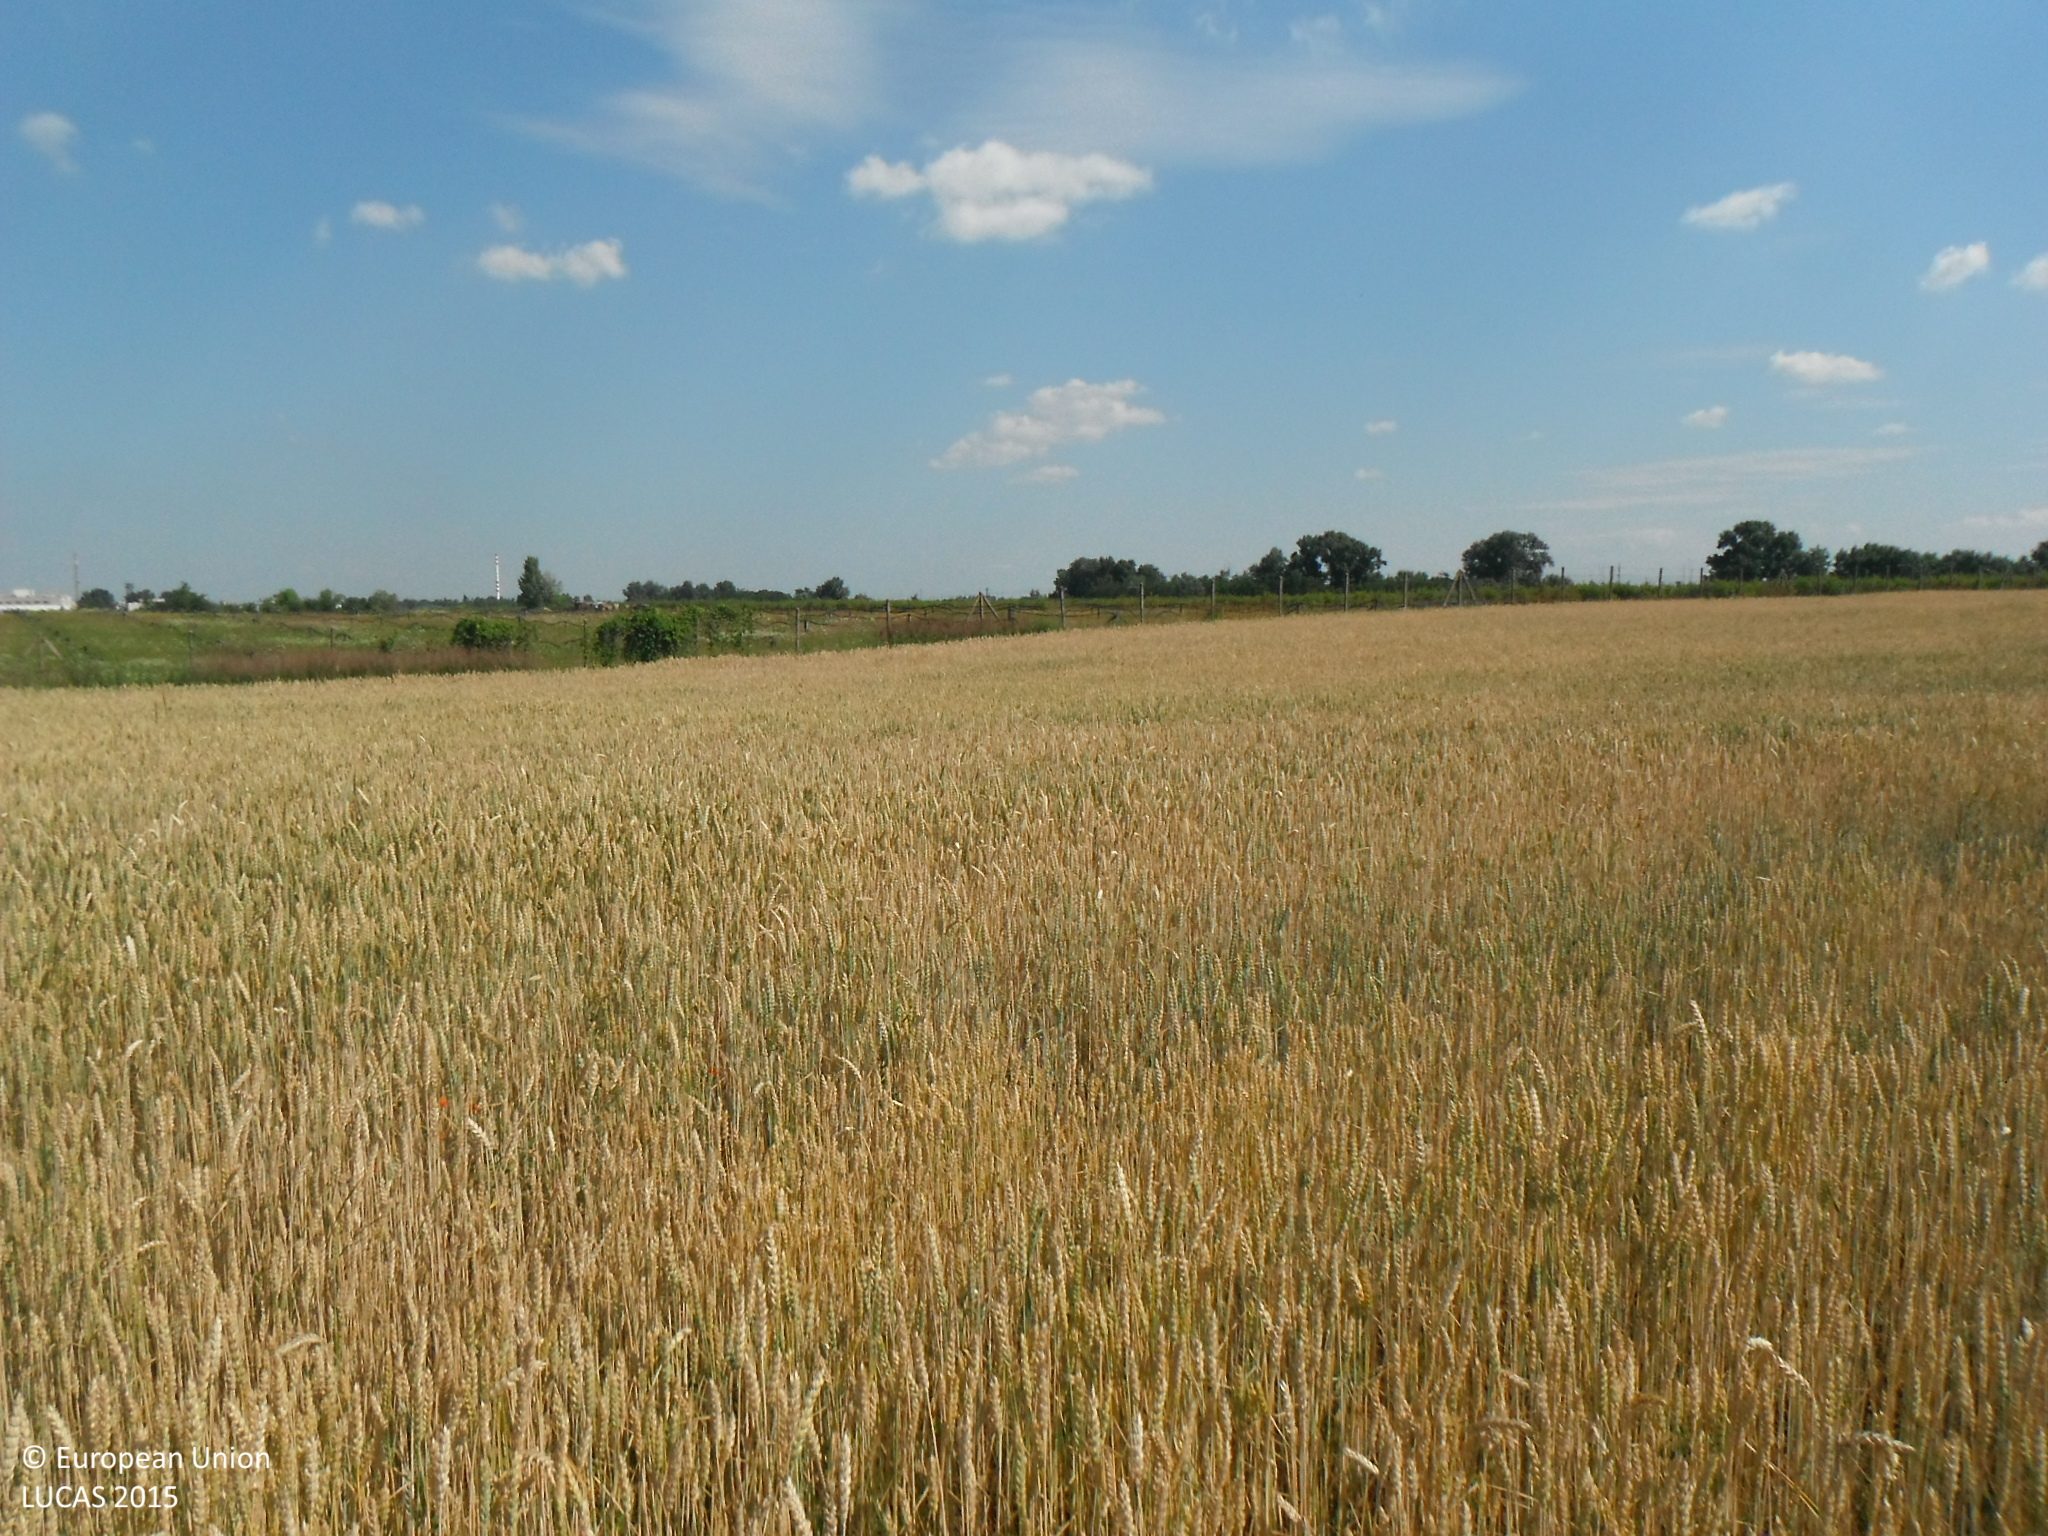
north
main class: Cropland
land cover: Common wheat
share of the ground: > 75 %
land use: Agriculture (excluding fallow land and kitchen gardens)
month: June
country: SK
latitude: 47.9543
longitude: 18.1951
